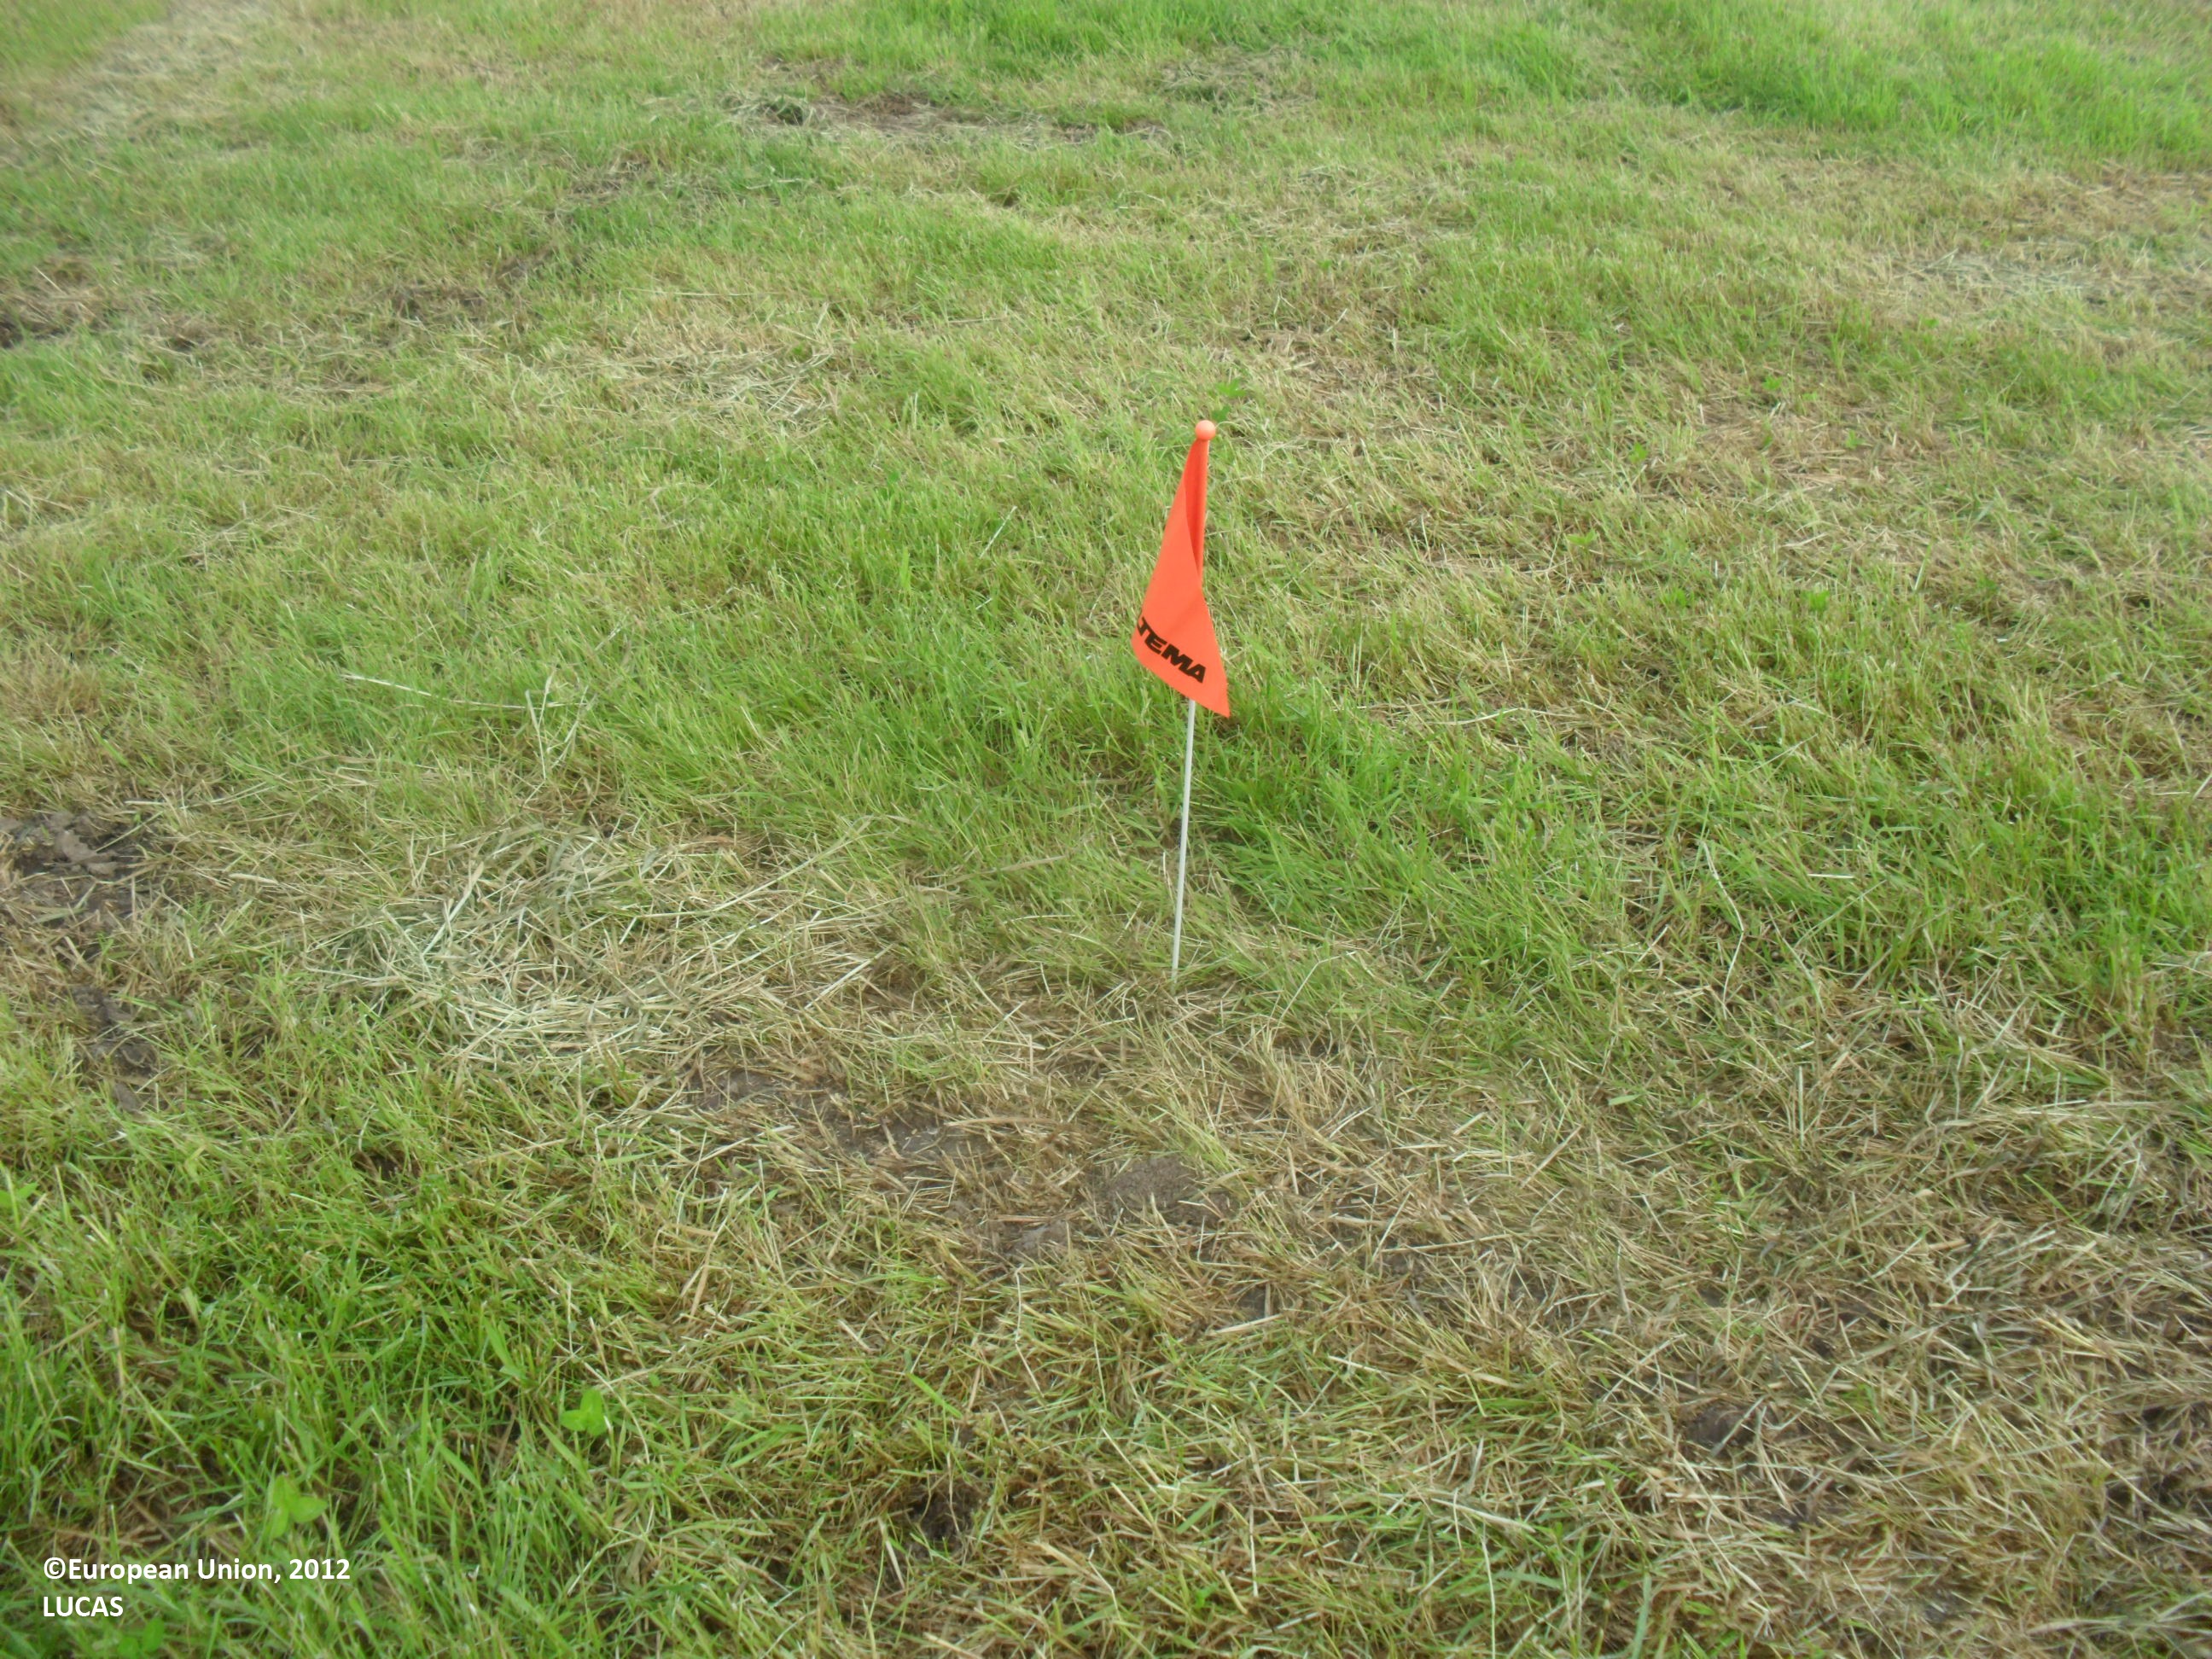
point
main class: Cropland
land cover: Temporary grasslands
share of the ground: > 75 %
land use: Agriculture (excluding fallow land and kitchen gardens)
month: June
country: FI
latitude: 63.3006
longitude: 23.3271
